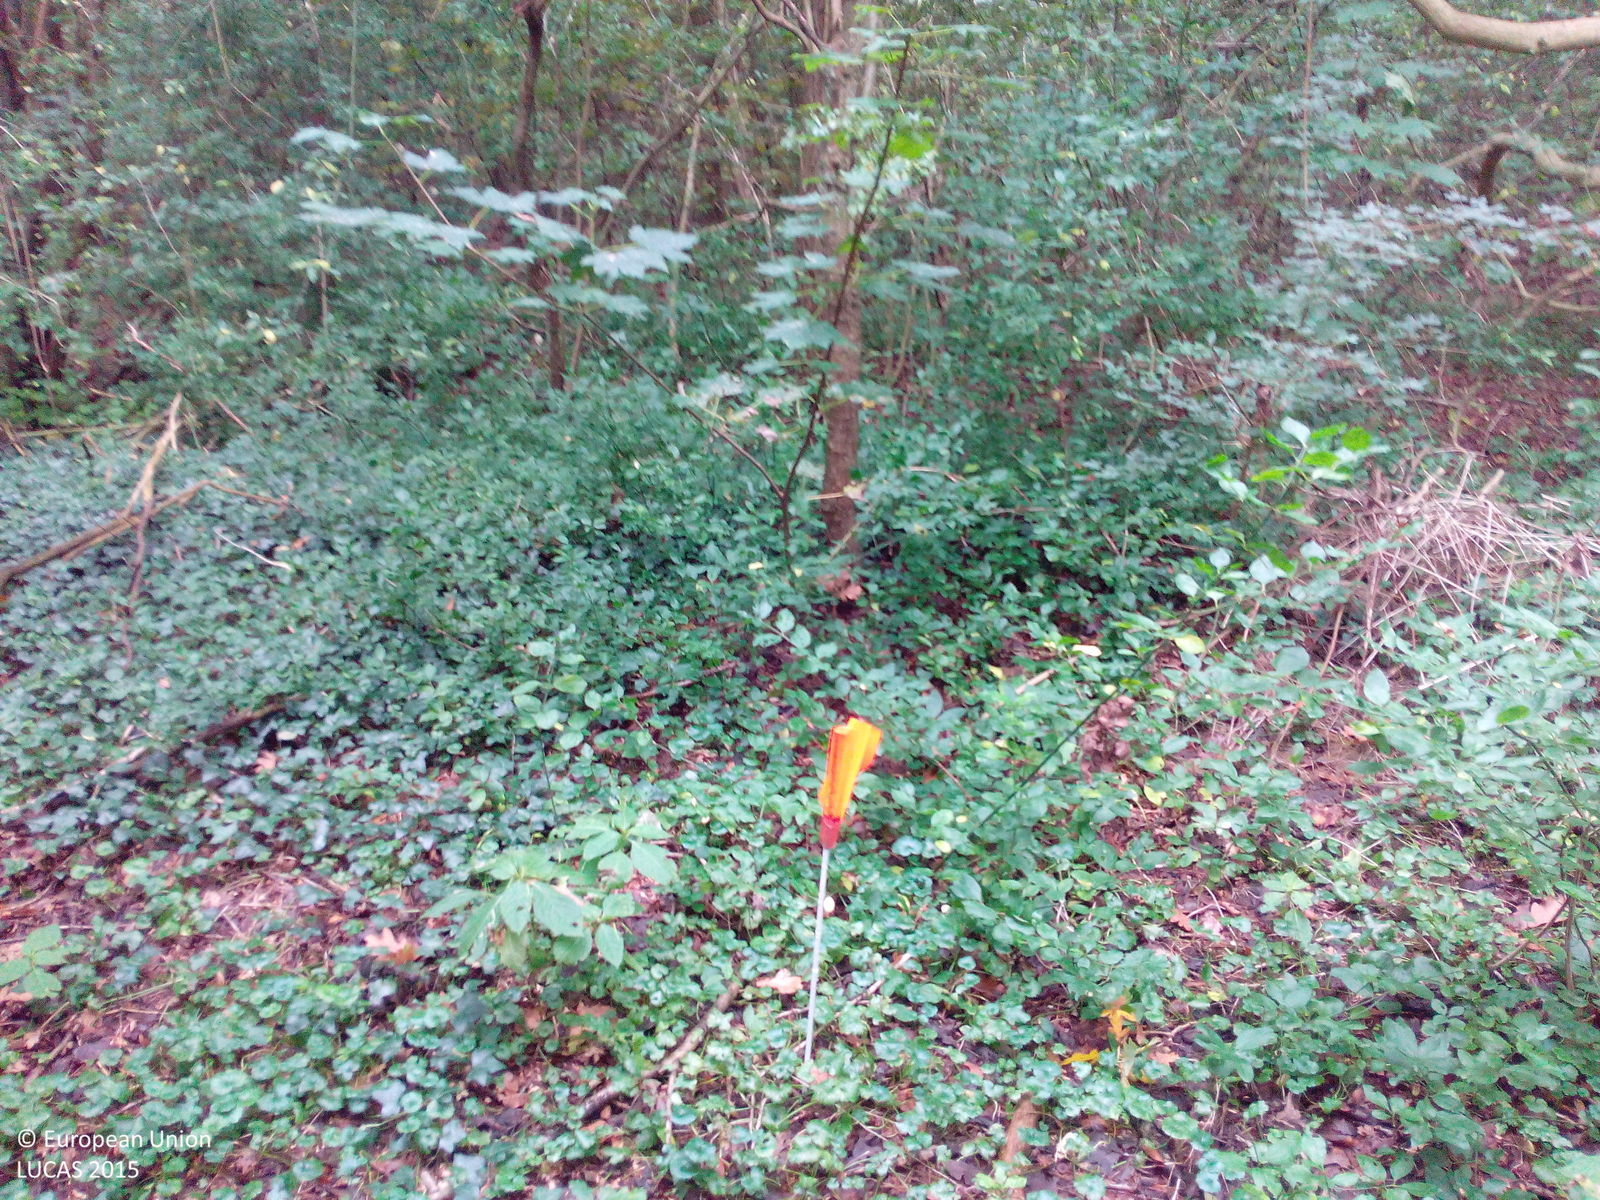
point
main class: Woodland
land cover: Broadleaved woodland
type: mesophytic deciduous forest
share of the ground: > 75 %
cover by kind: broadleaved forest trees 80 %, shrubs 10 %, herbaceous plants 10 %
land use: Amenities, museums, leisure
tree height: > 5 m
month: September
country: NL
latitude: 52.5449
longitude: 4.6438
